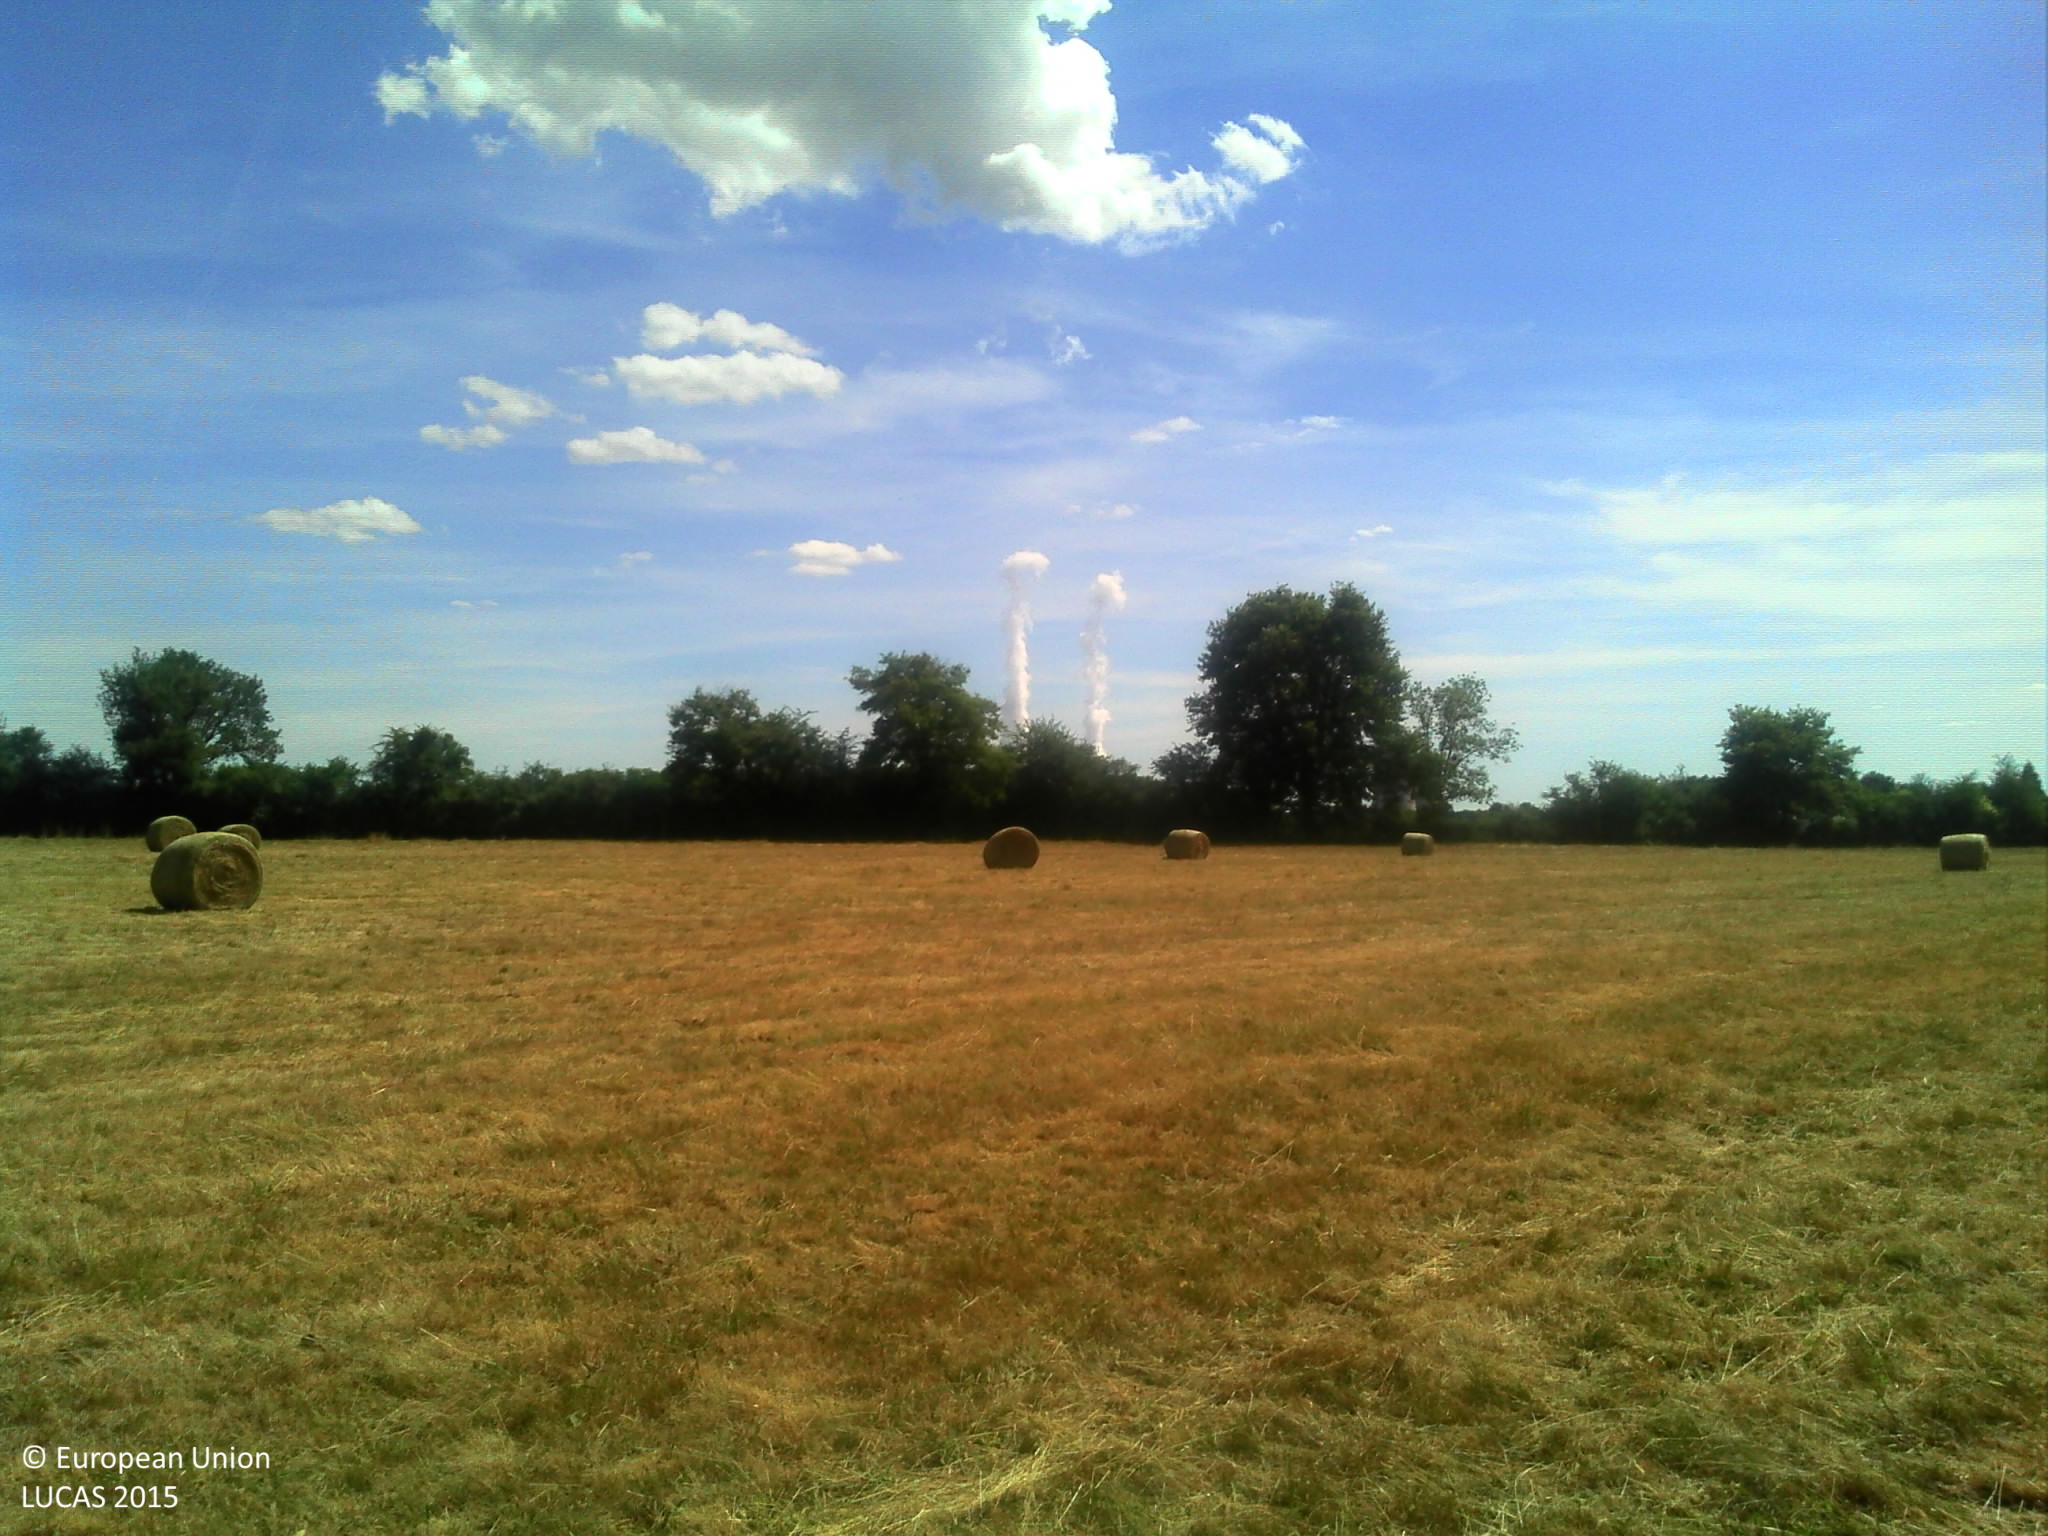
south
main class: Grassland
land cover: Grassland without tree/shrub cover
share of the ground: > 75 %
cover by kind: herbaceous plants 100 %
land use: Agriculture (excluding fallow land and kitchen gardens)
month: June
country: FR
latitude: 47.7713
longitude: 2.5321
